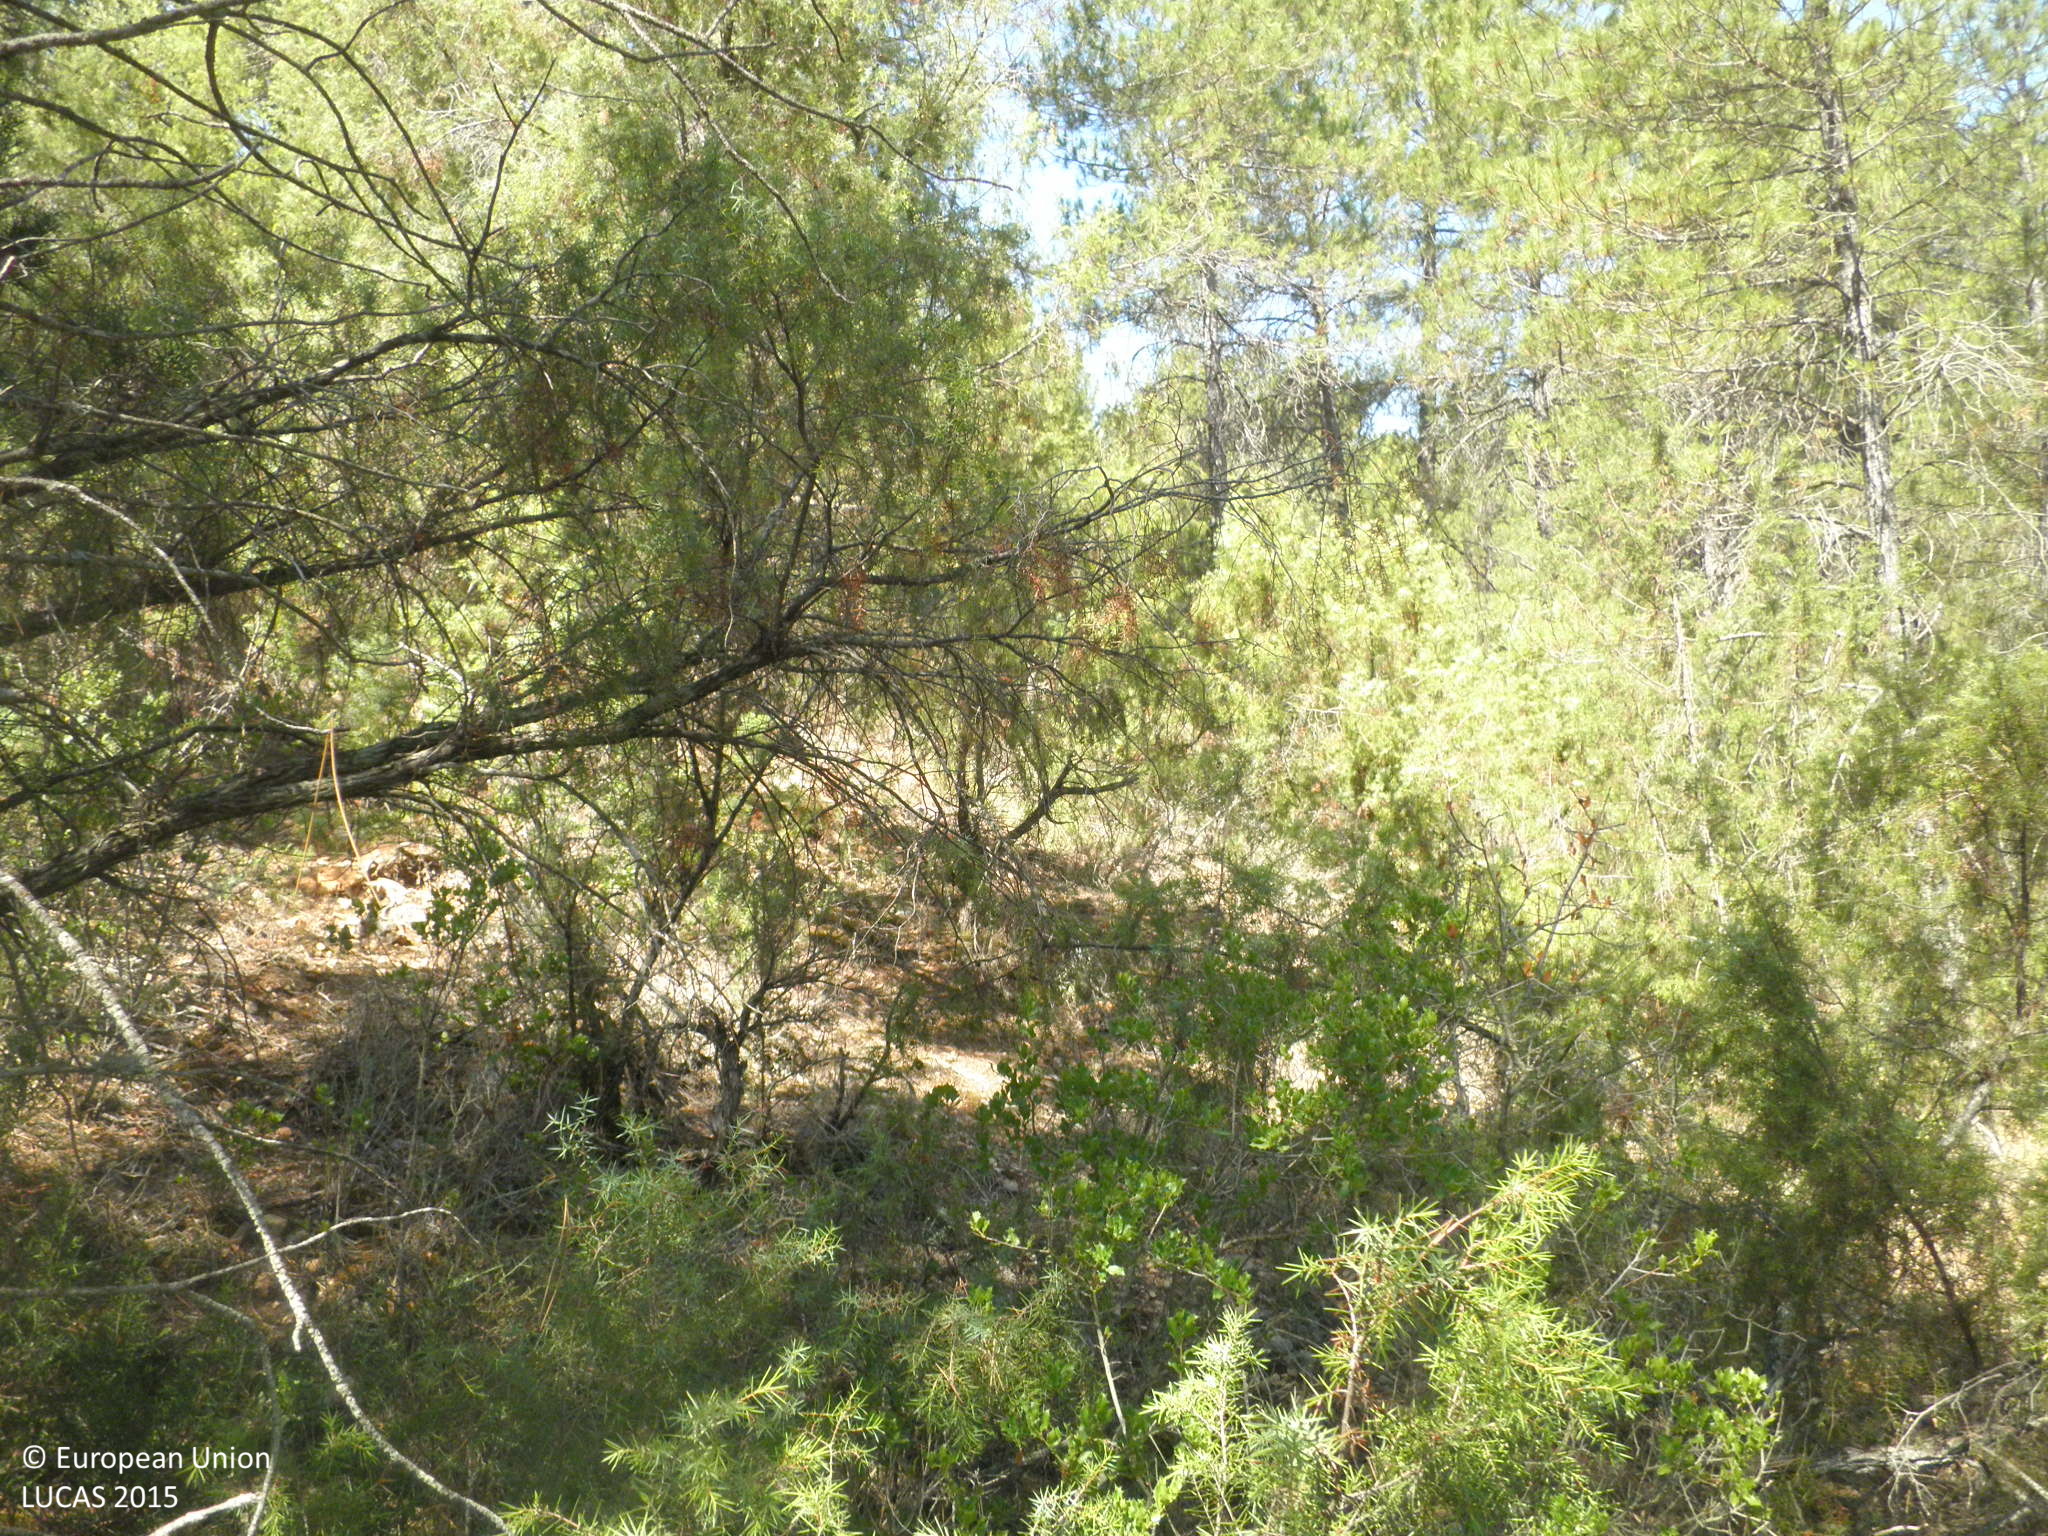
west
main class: Woodland
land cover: Pine dominated coniferous woodland
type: coniferous forest of the mediterranean region
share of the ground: 50 - 75 %
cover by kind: coniferous forest trees 60 %, unconsolidated bare surface 20 %, shrubs 15 %, herbaceous plants 5 %
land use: Semi-natural and natural areas not in use
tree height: > 5 m
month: July
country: ES
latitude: 39.6866
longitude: -1.7498
